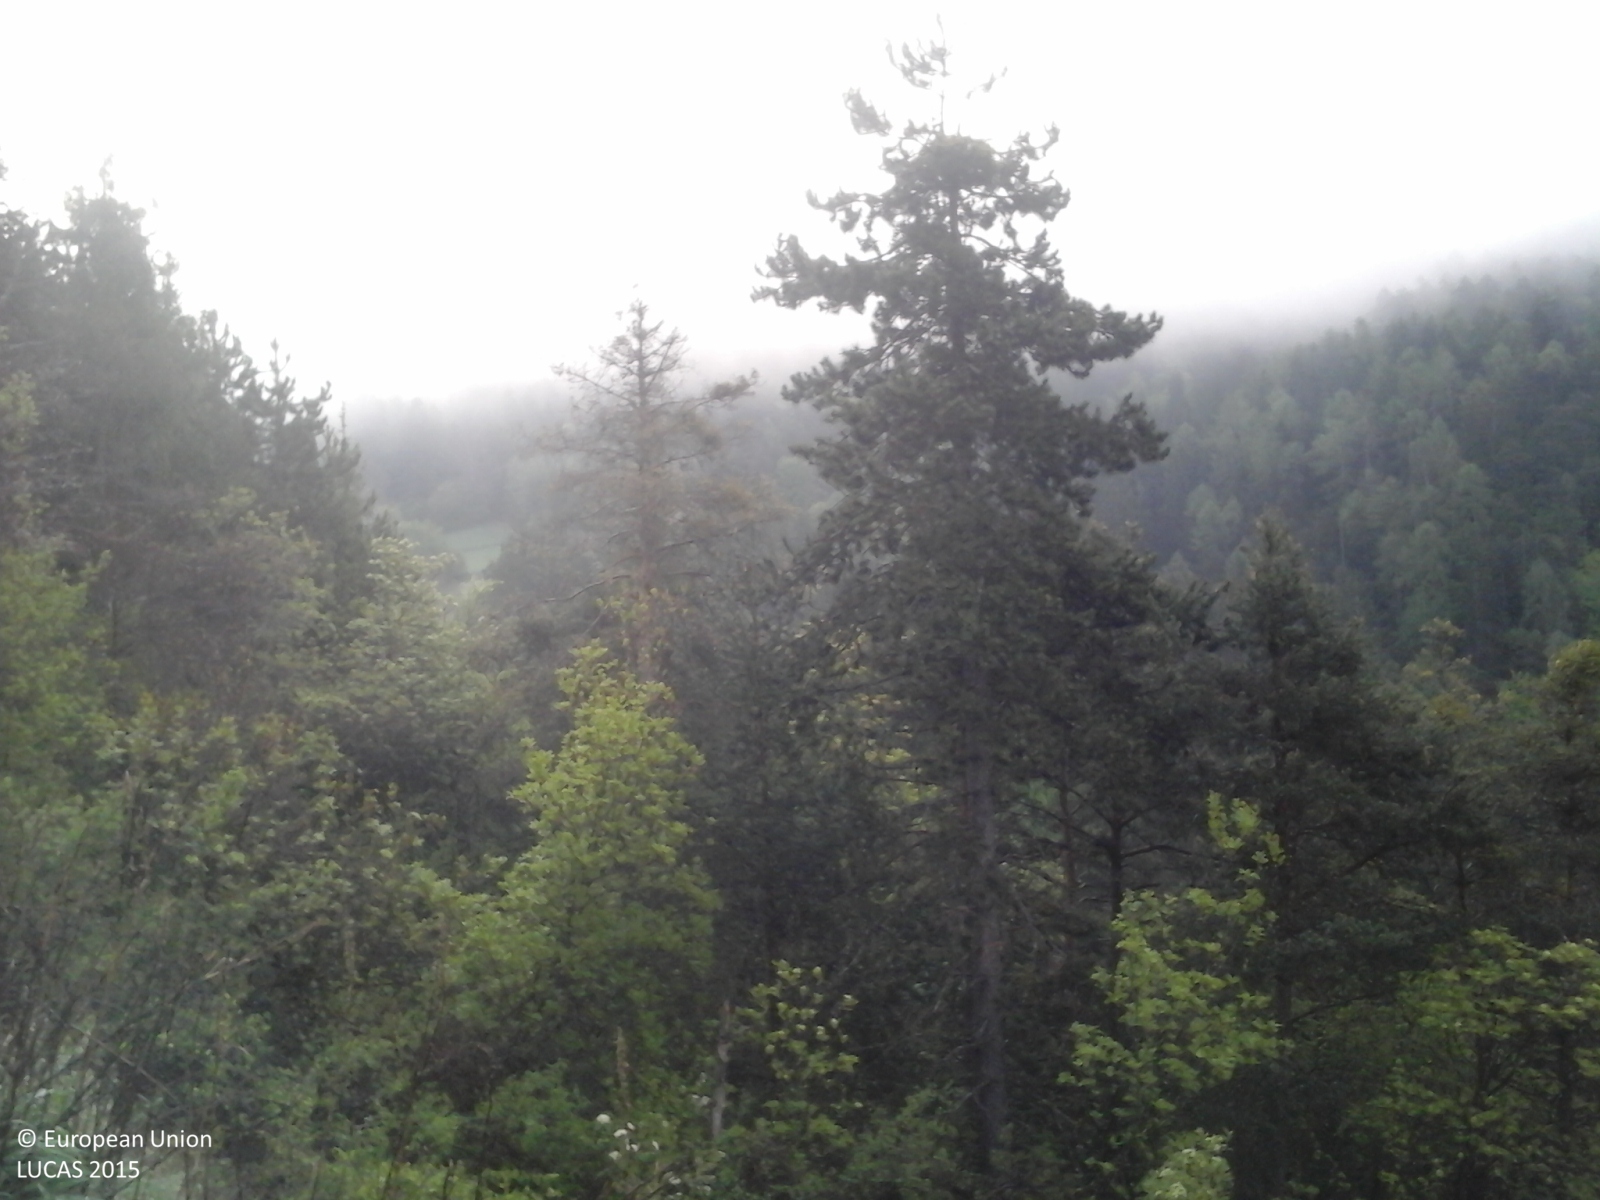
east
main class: Woodland
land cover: Spruce dominated mixed woodland
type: alpine coniferous forest
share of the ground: > 75 %
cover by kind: coniferous forest trees 50 %, broadleaved forest trees 50 %
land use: Forestry
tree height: > 5 m
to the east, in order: Spruce dominated mixed woodland
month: May
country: IT
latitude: 46.3813
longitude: 11.1297
